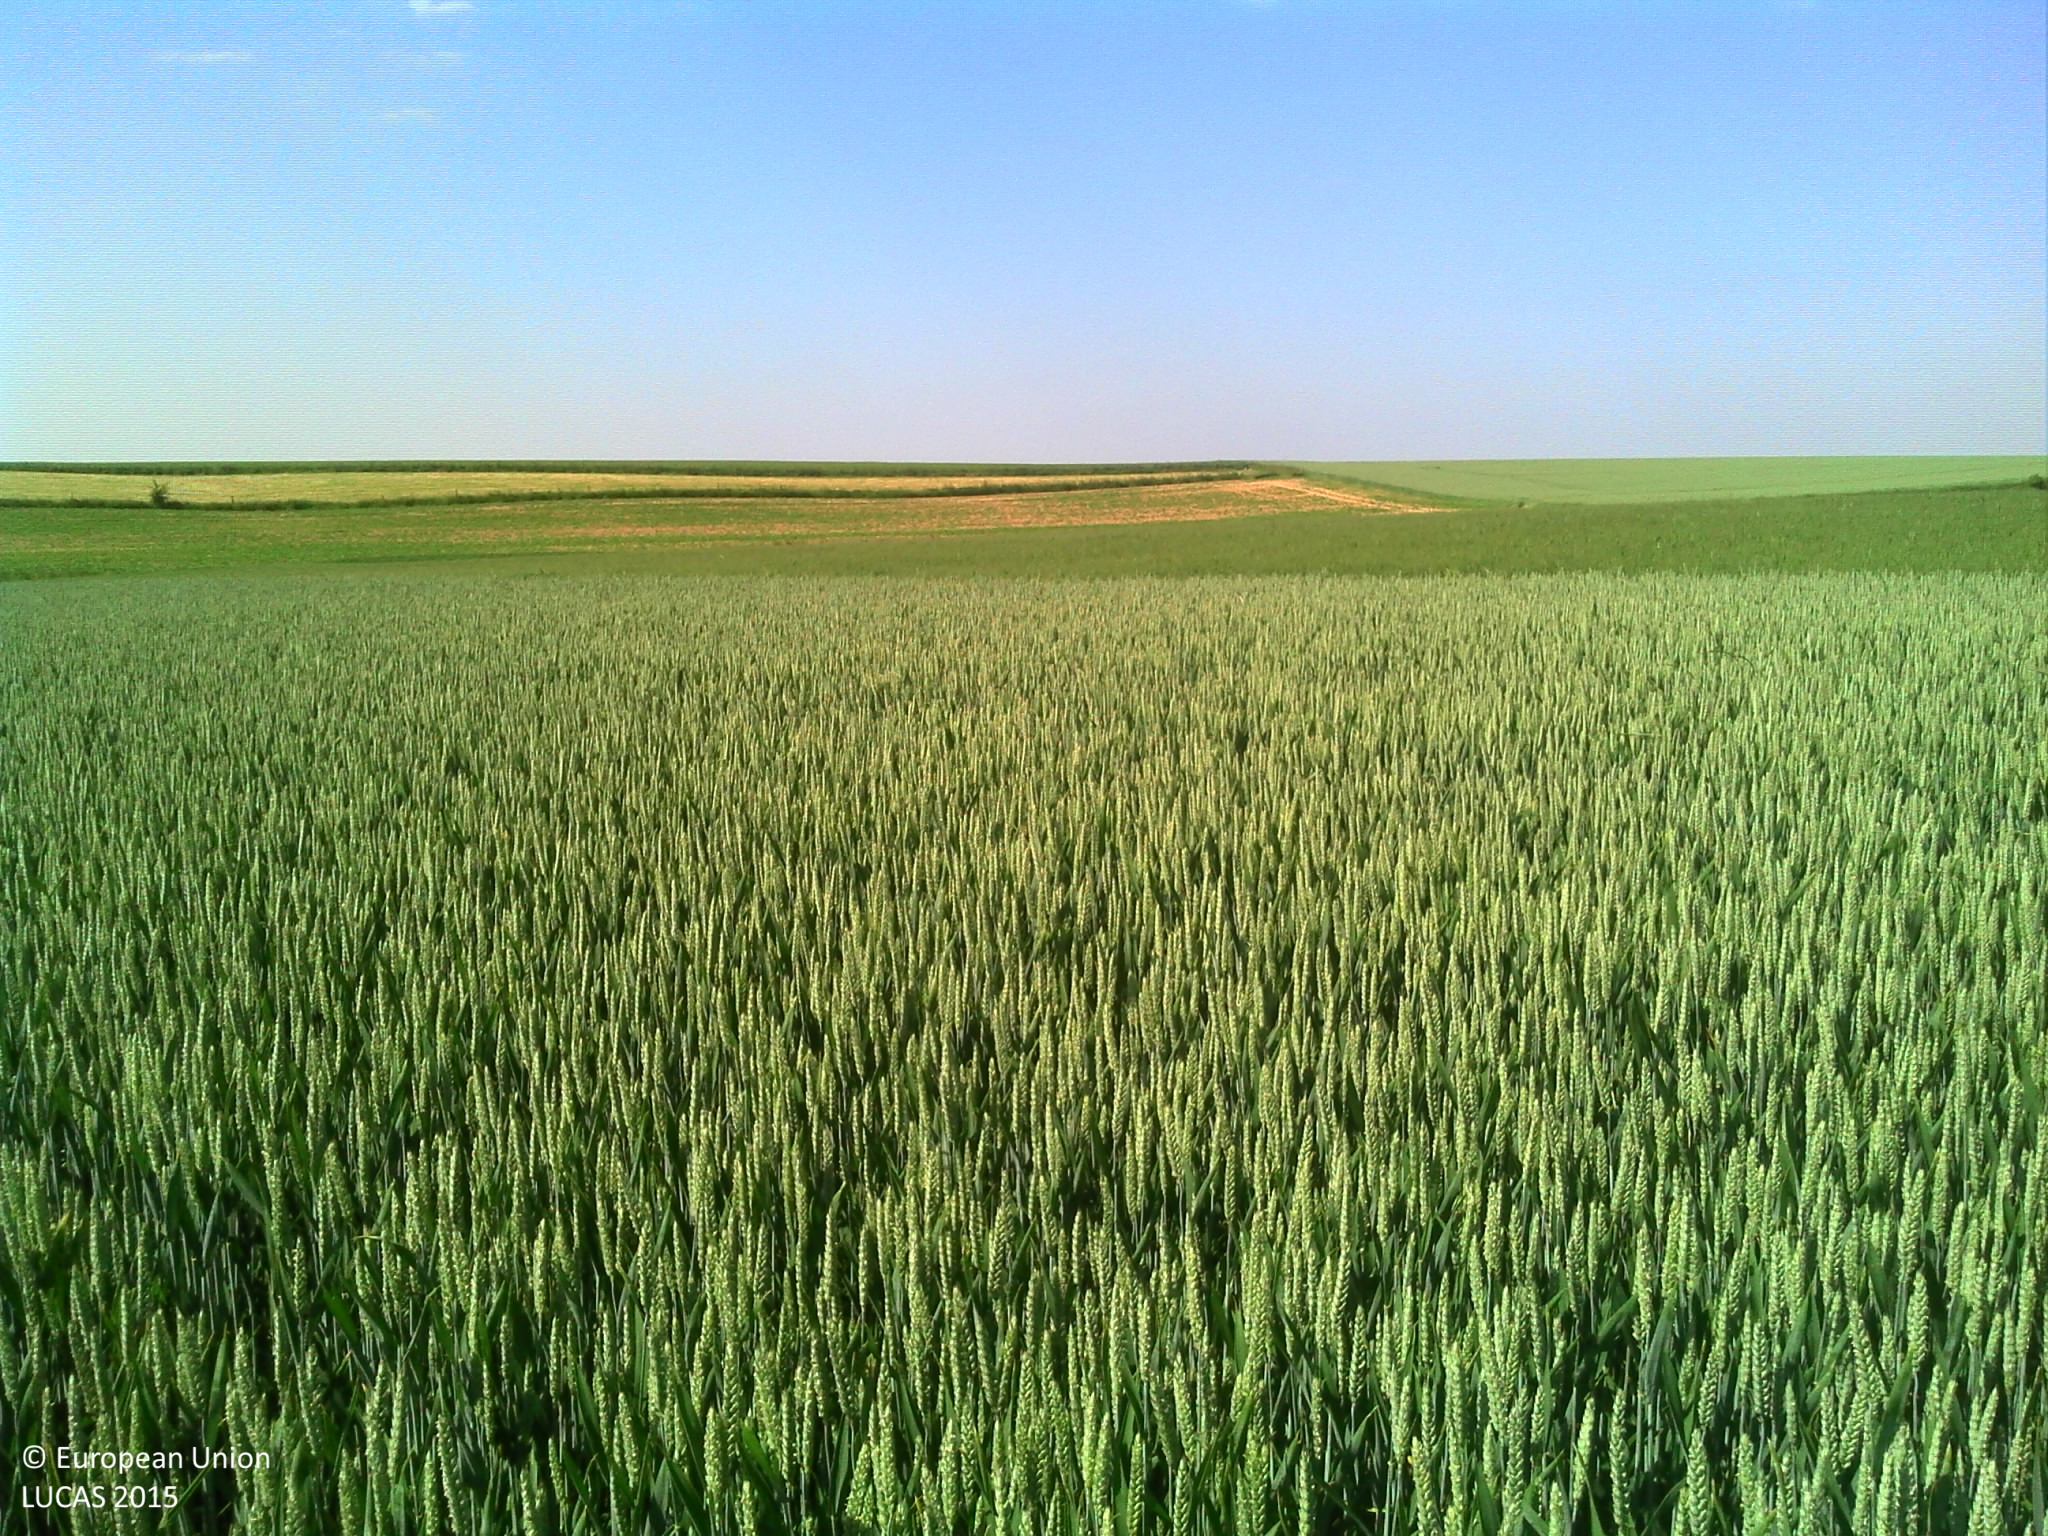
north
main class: Cropland
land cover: Common wheat
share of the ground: > 75 %
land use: Agriculture (excluding fallow land and kitchen gardens)
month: June
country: FR
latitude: 49.7564
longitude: 4.0119
